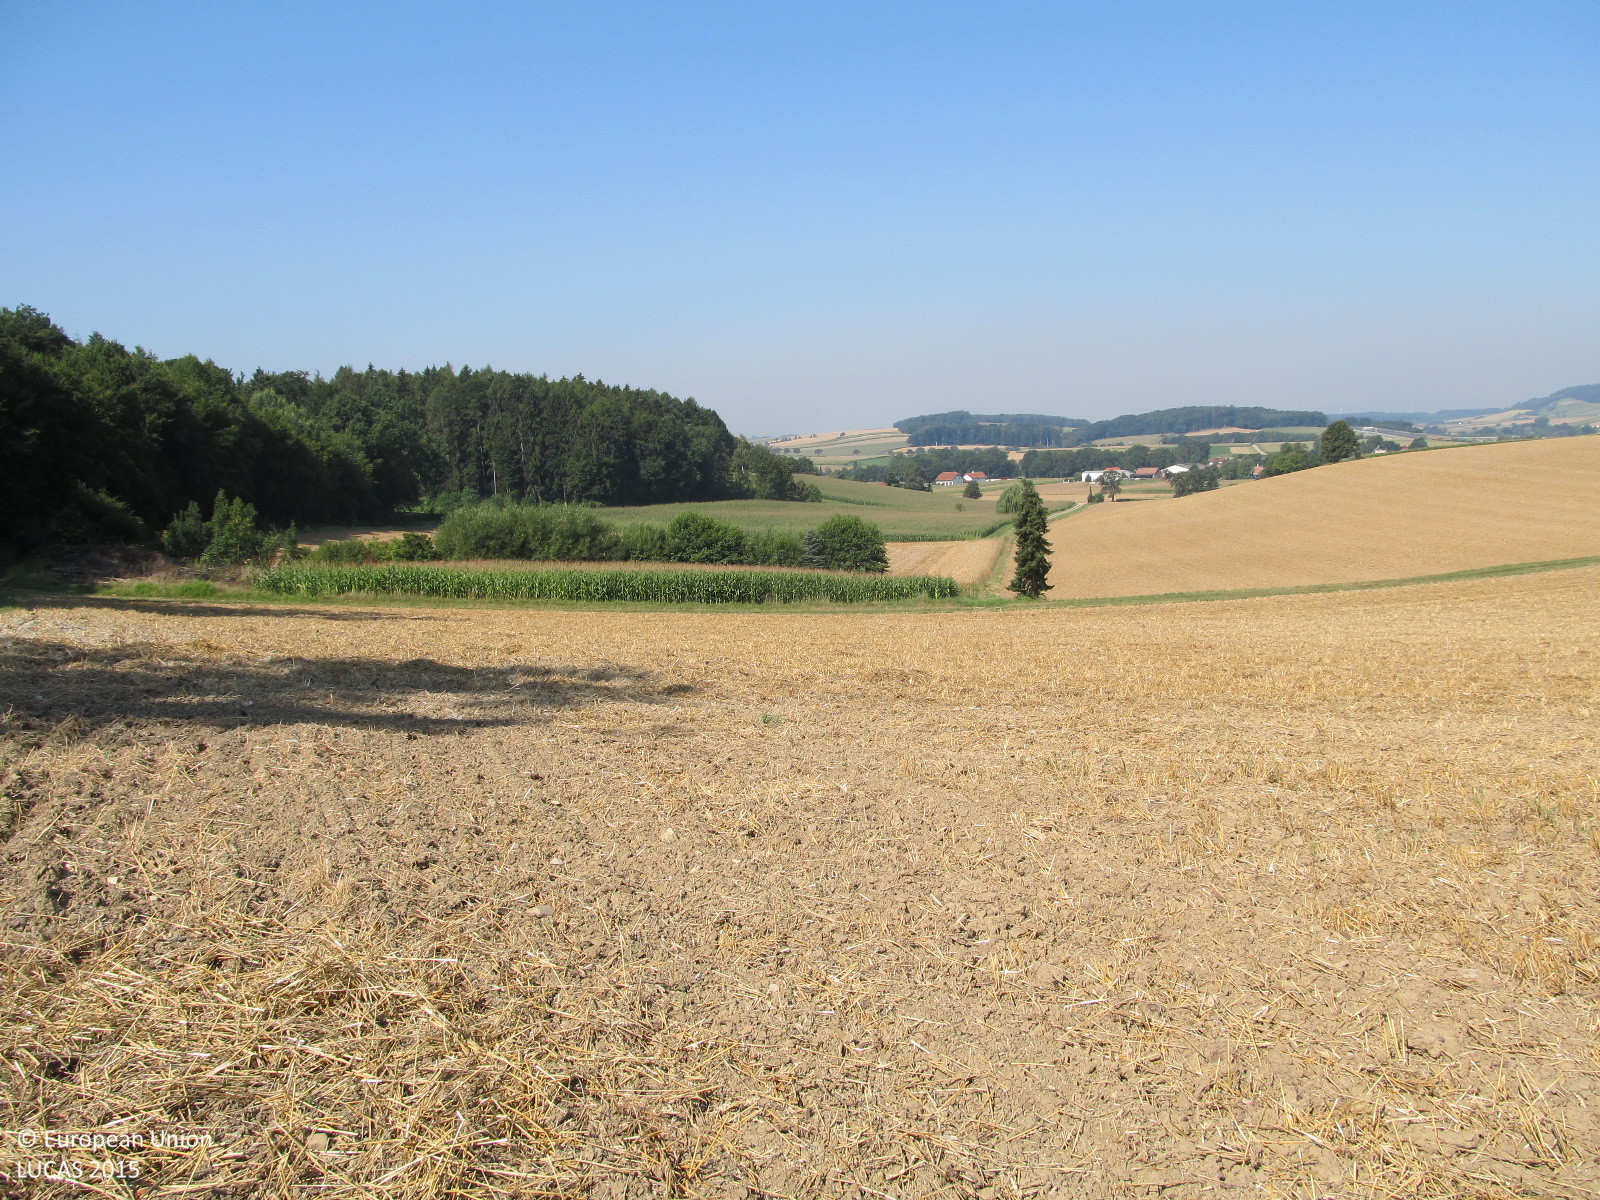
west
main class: Cropland
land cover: Common wheat
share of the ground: 10 - 25 %
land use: Agriculture (excluding fallow land and kitchen gardens)
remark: Harvested field
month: August
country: AT
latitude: 48.1805
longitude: 15.7728
